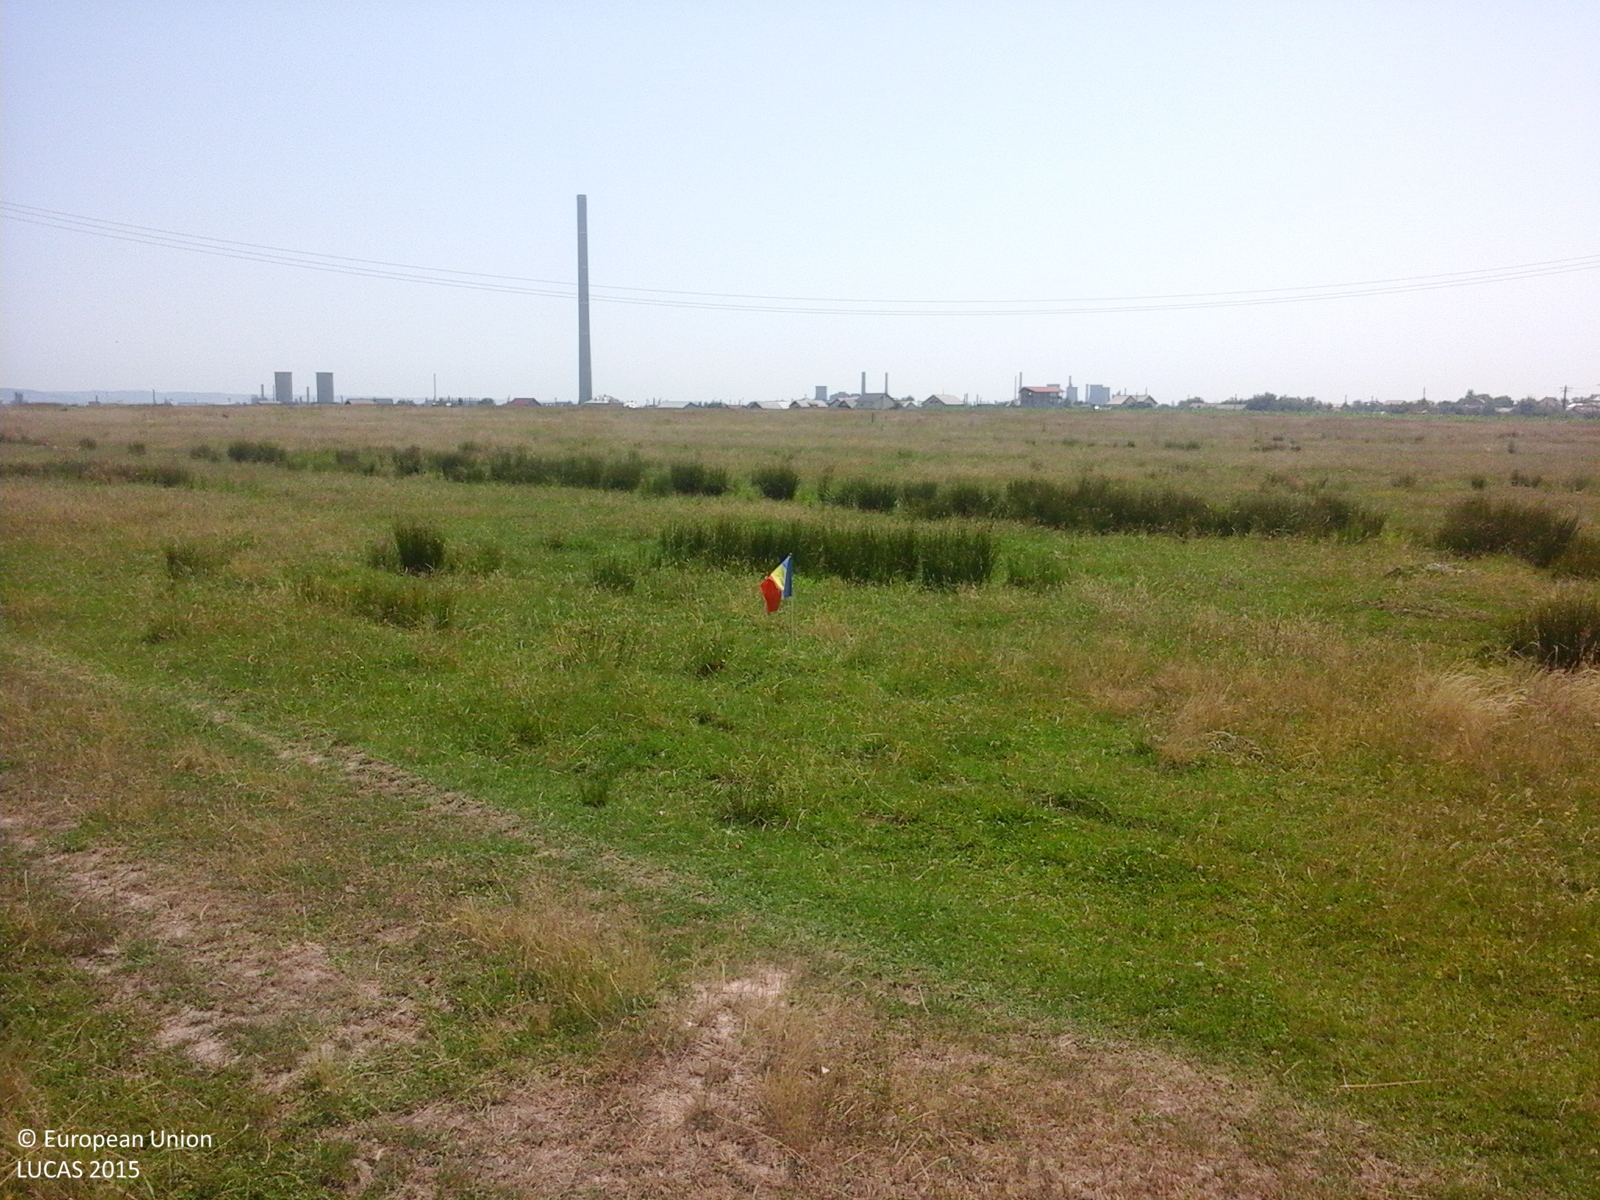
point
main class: Grassland
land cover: Grassland without tree/shrub cover
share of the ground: > 75 %
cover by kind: herbaceous plants 100 %
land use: Agriculture (excluding fallow land and kitchen gardens)
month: July
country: RO
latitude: 44.8079
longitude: 24.8873
